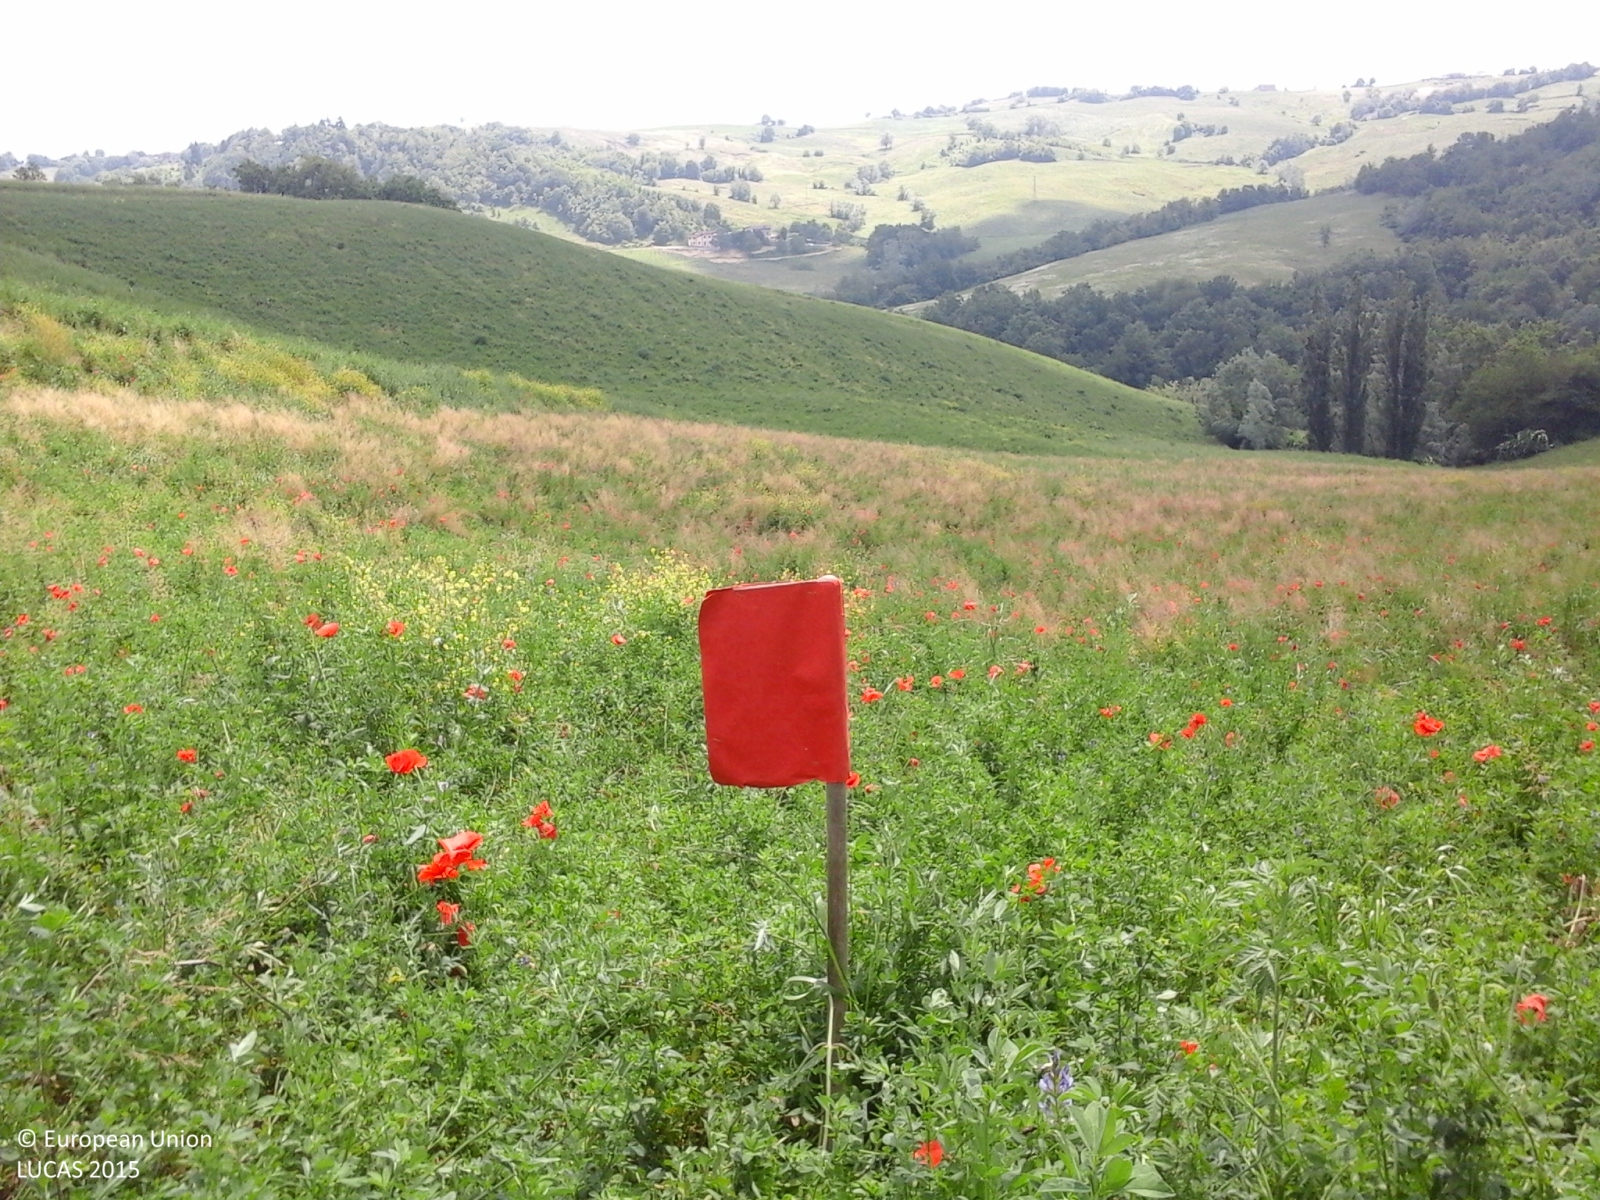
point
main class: Cropland
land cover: Lucerne
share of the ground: > 75 %
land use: Agriculture (excluding fallow land and kitchen gardens)
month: May
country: IT
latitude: 44.6569
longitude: 10.2391
